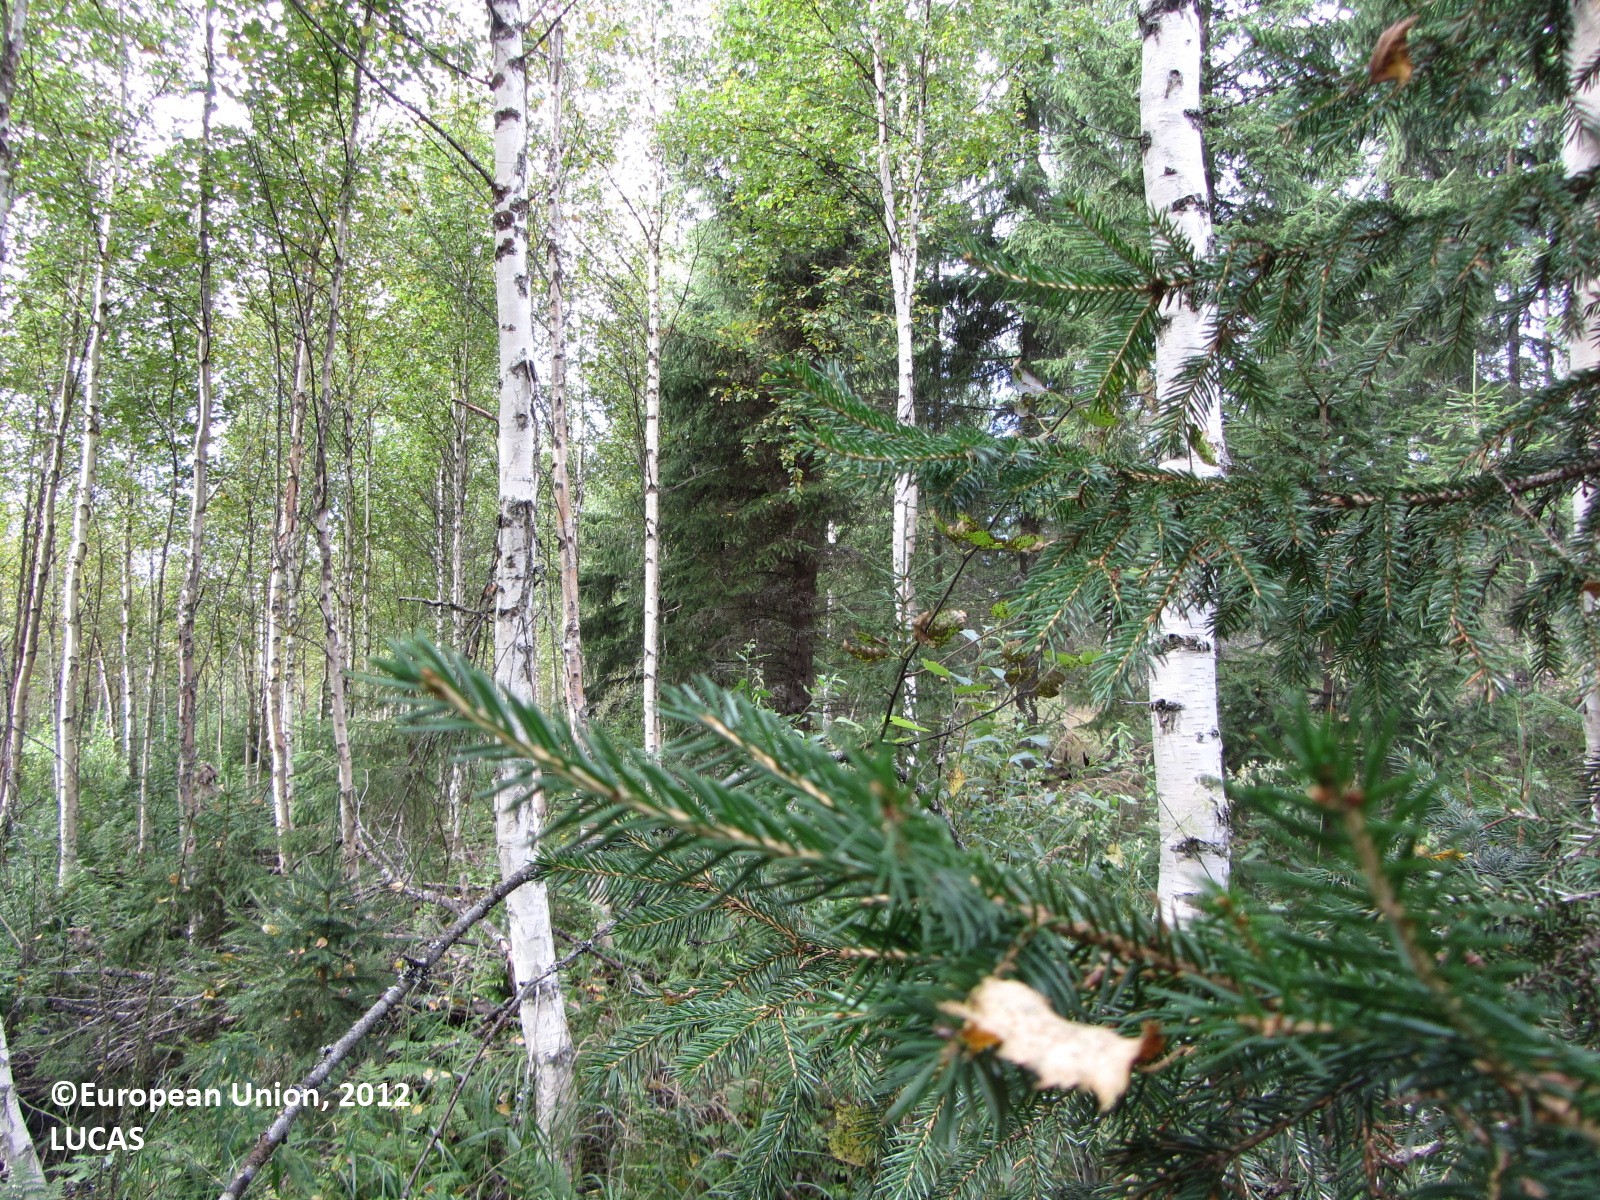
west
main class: Woodland
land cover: Spruce dominated mixed woodland
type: boreal forest
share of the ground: > 75 %
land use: Forestry
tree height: > 5 m
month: August
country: FI
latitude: 63.2523
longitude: 25.2135
